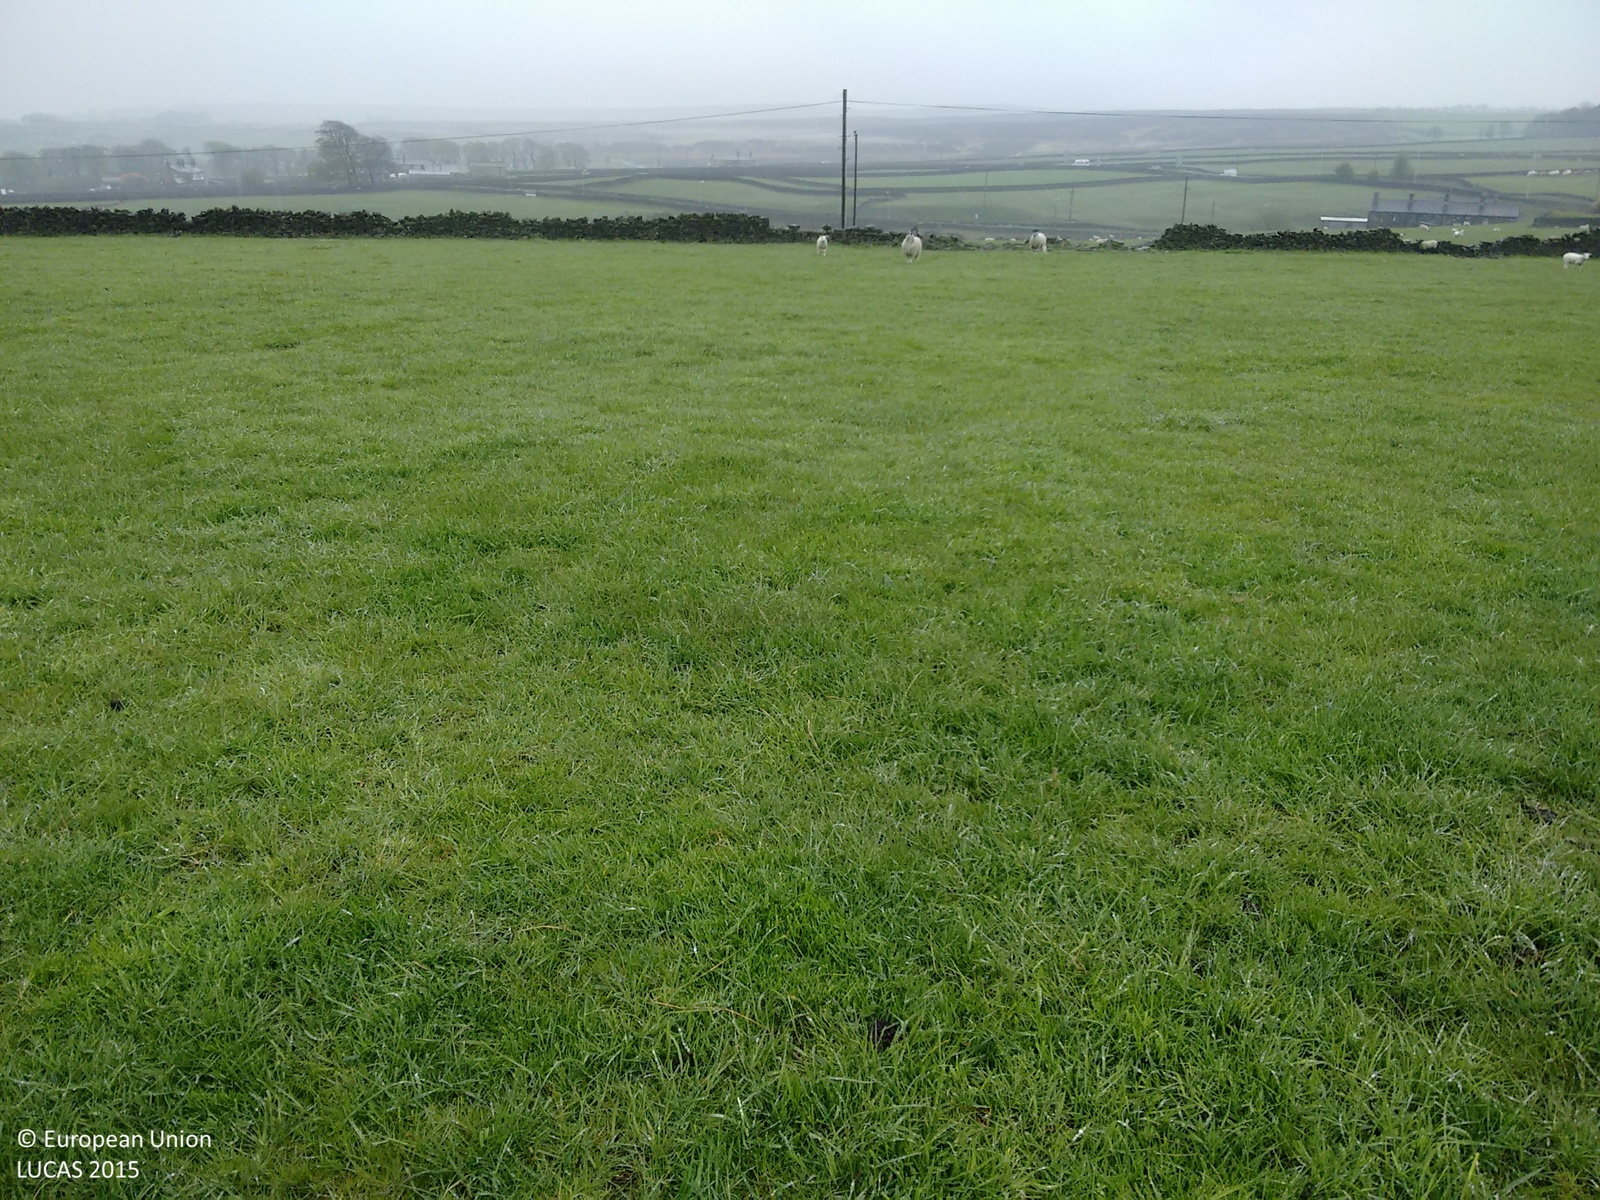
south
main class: Grassland
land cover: Grassland without tree/shrub cover
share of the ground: > 75 %
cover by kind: herbaceous plants 100 %
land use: Agriculture (excluding fallow land and kitchen gardens)
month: May
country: GB
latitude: 53.8288
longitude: -1.9218
